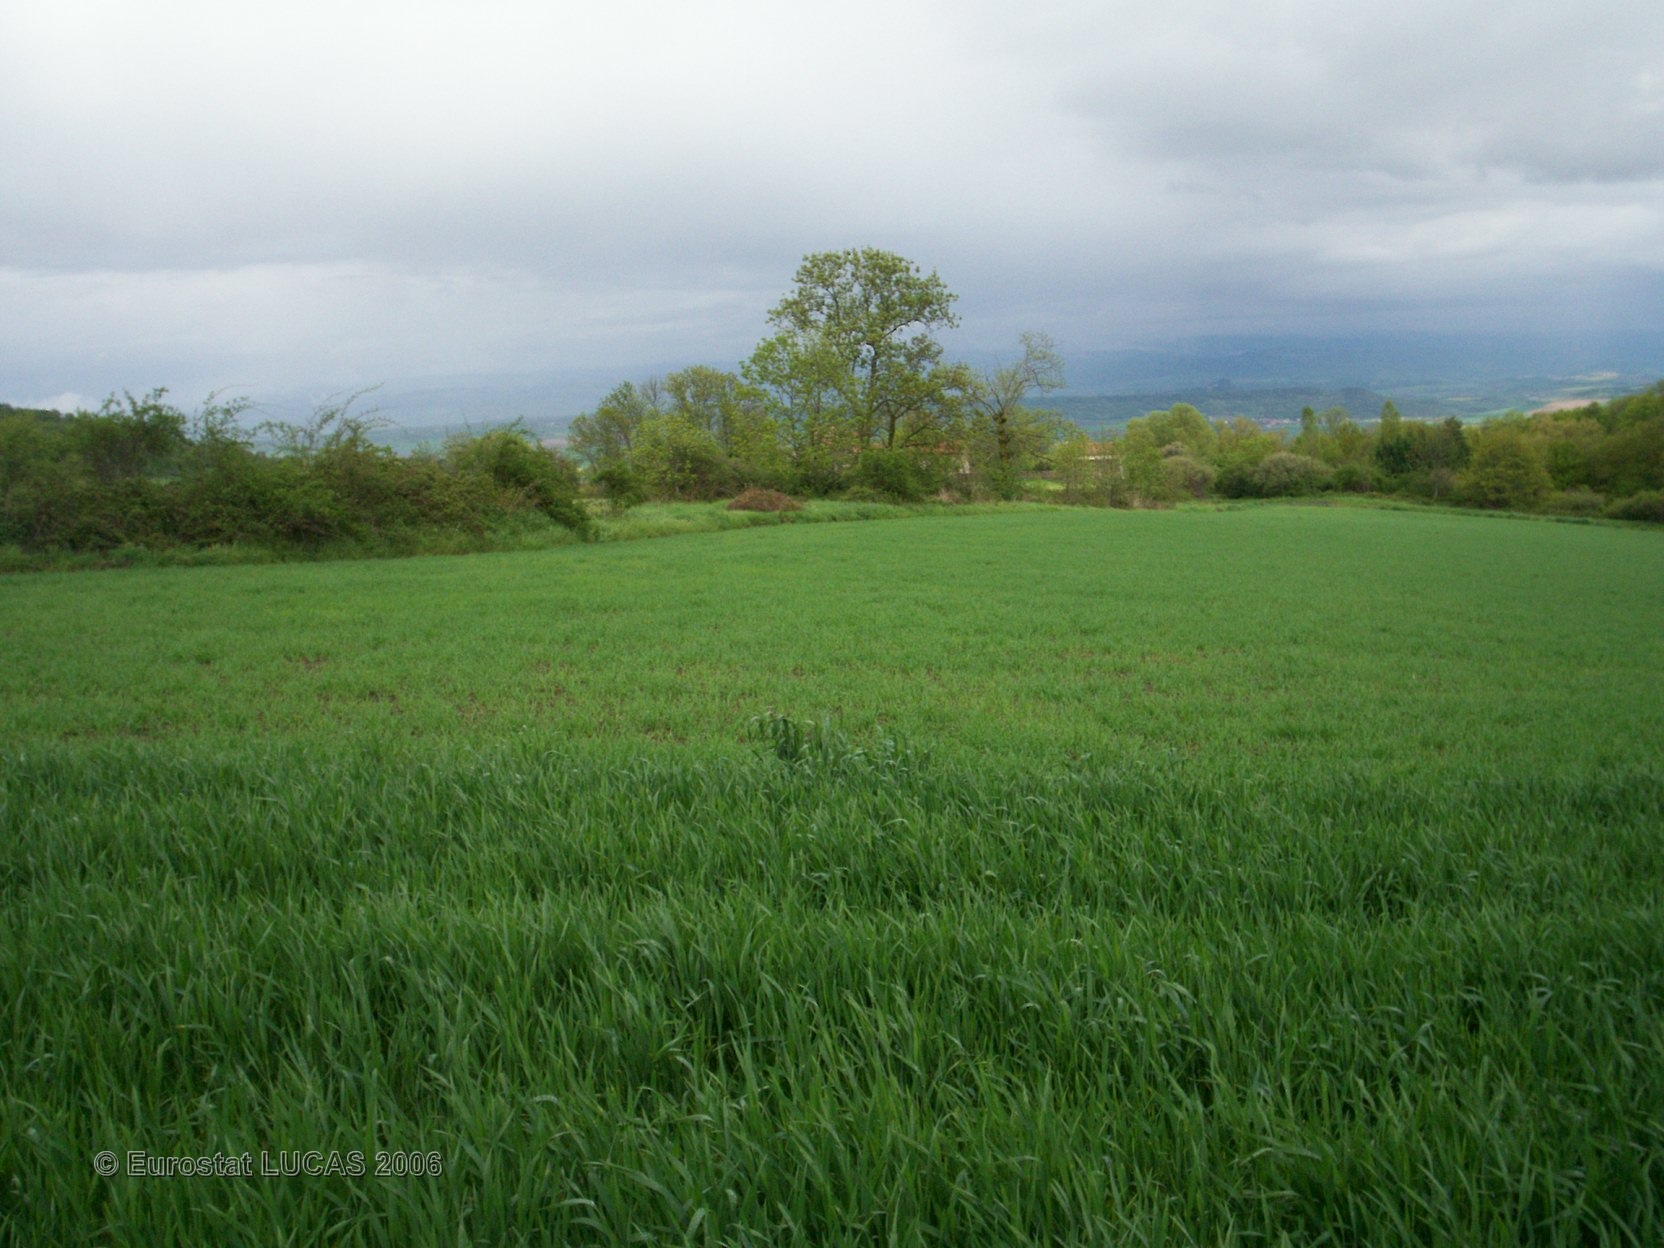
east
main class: Cropland
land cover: Common wheat
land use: Agriculture (excluding fallow land and kitchen gardens)
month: May
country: FR
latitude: 45.4974
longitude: 3.1287
